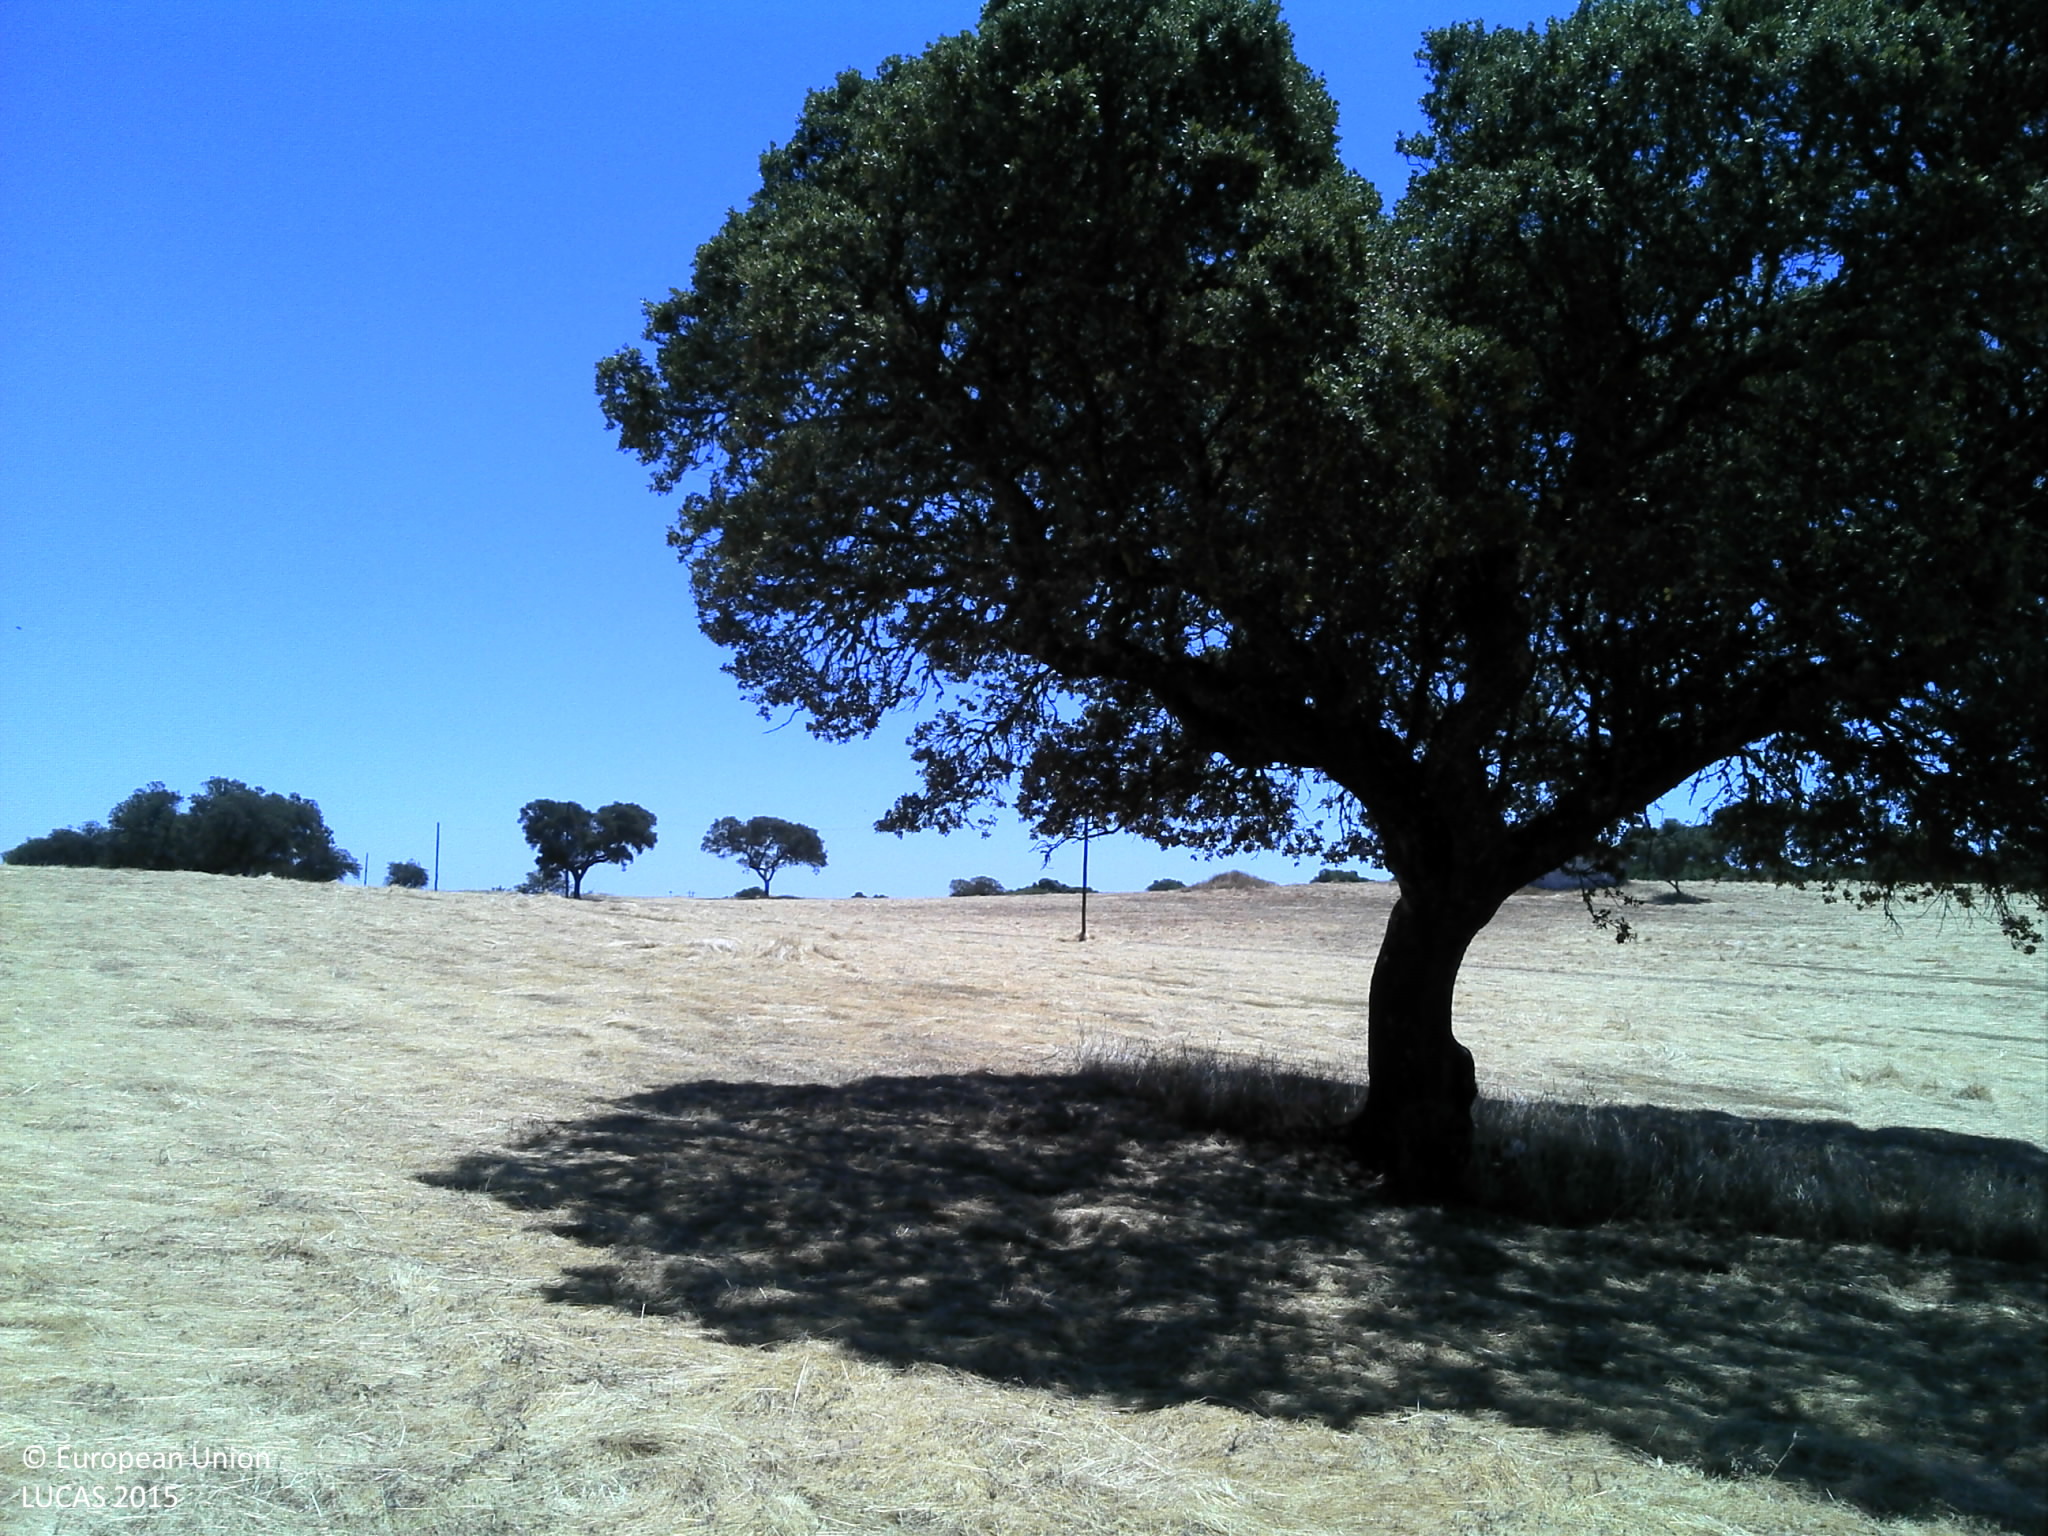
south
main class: Woodland
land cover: Broadleaved woodland
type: broadleaved evergreen forest
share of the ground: 10 - 25 %
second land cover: Grassland without tree/shrub cover
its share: 50 - 75 %
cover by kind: herbaceous plants 75 %, unconsolidated bare surface 15 %, broadleaved forest trees 10 %
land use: Forestry
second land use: Agriculture (excluding fallow land and kitchen gardens)
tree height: > 5 m
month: June
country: PT
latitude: 38.7135
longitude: -8.2089
